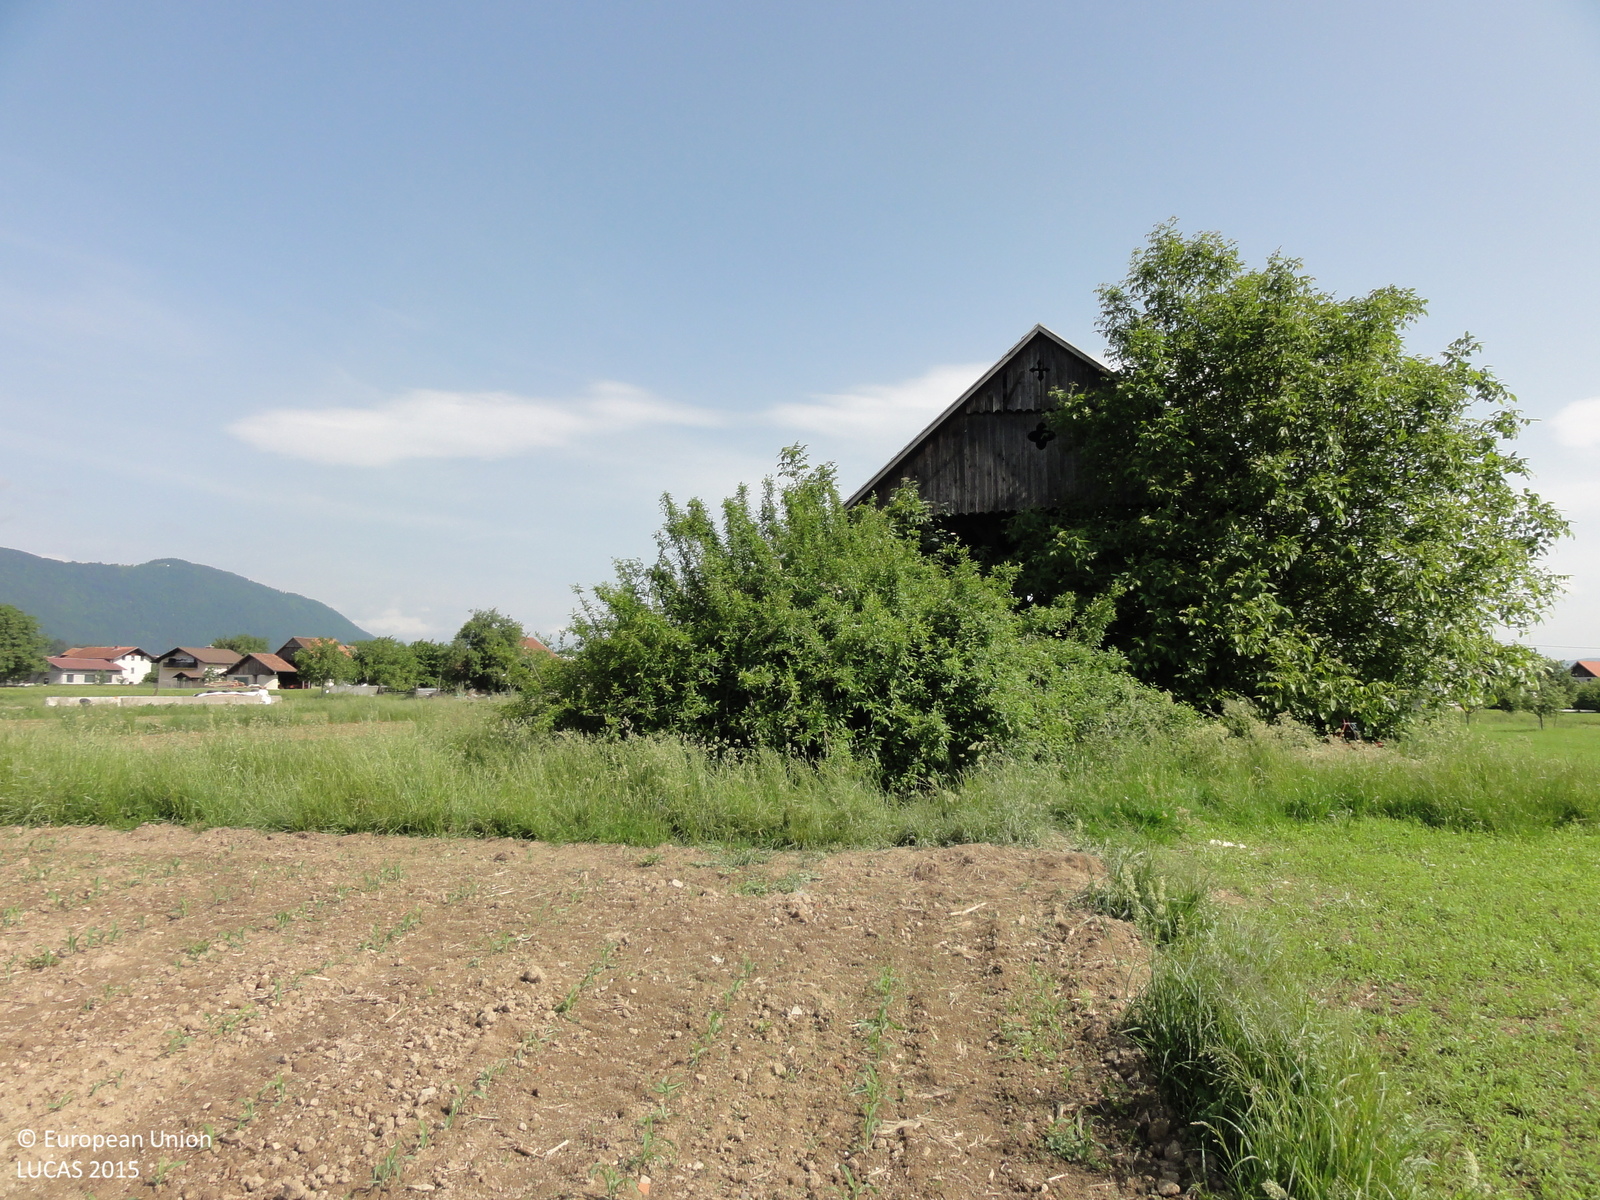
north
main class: Cropland
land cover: Maize
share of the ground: > 75 %
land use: Agriculture (excluding fallow land and kitchen gardens)
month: May
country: SI
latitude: 46.2503
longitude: 15.0432
